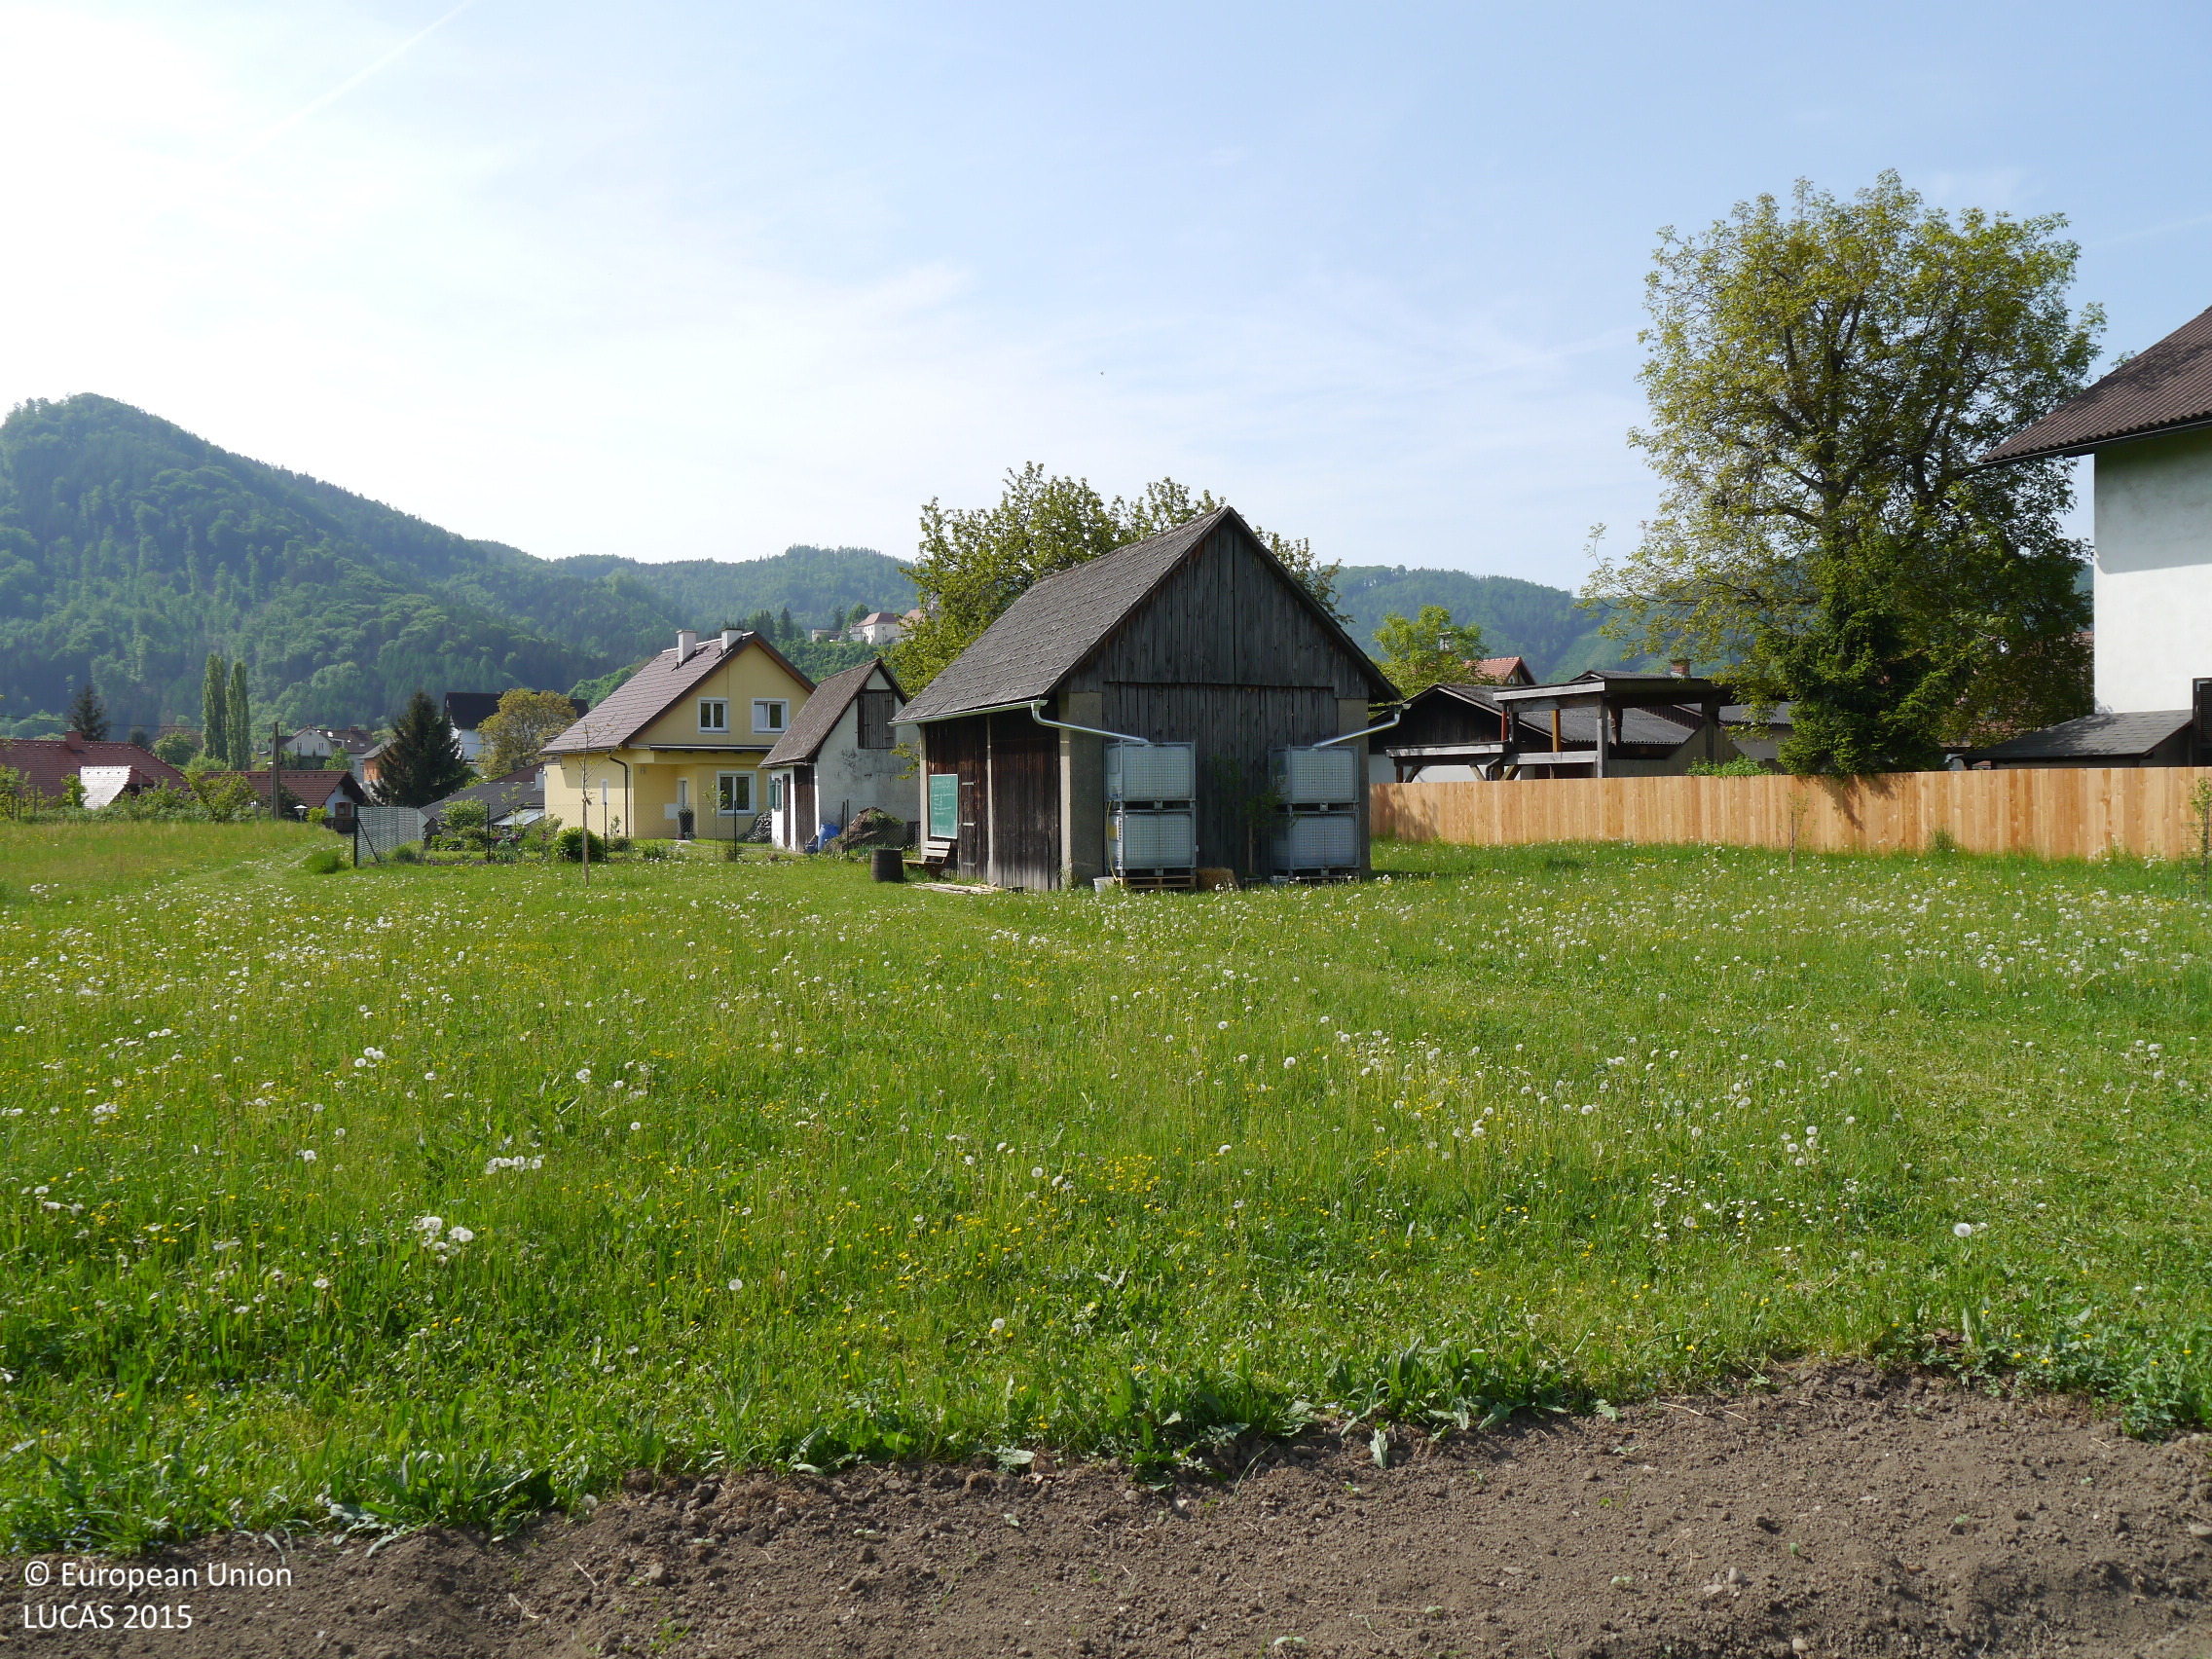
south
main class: Cropland
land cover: Other fresh vegetables
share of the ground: 50 - 75 %
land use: Kitchen garden
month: May
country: AT
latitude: 47.1202
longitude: 15.3379
